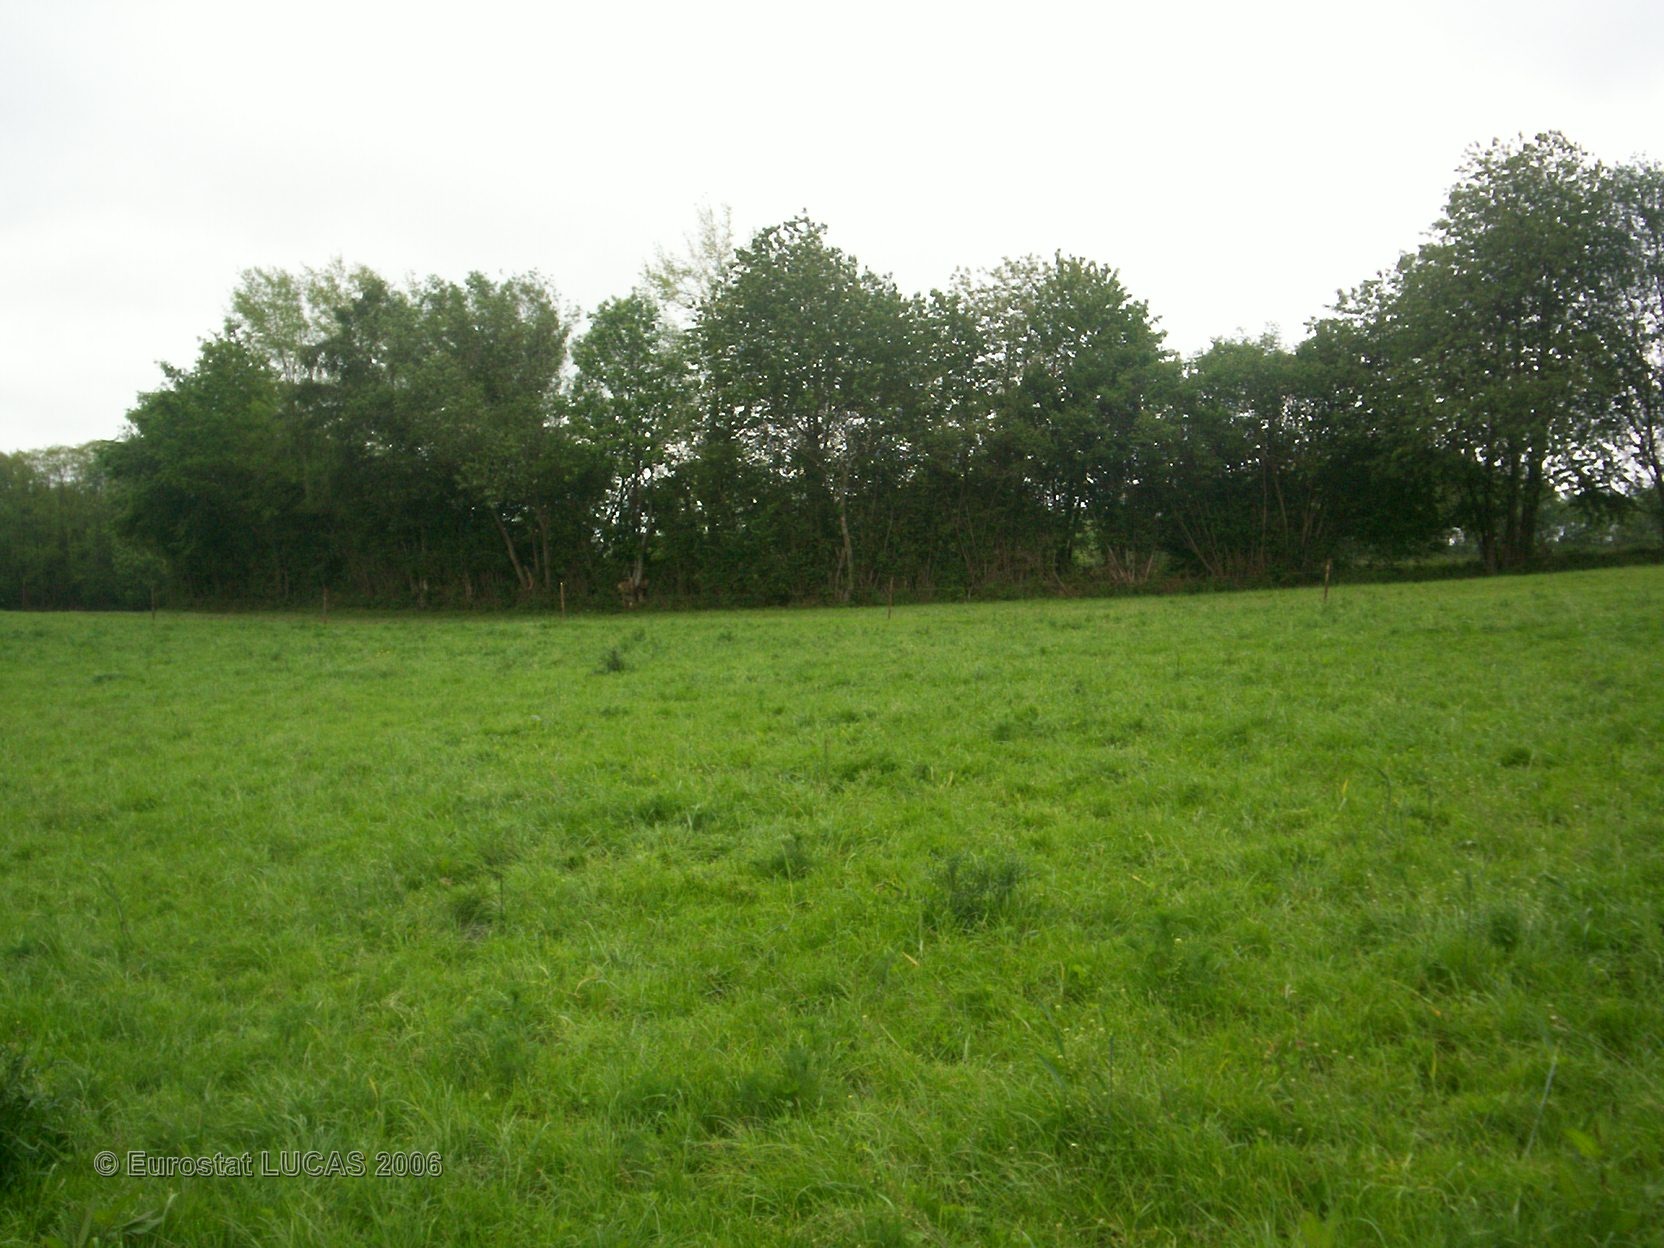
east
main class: Grassland
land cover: Grassland without tree/shrub cover
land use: Agriculture (excluding fallow land and kitchen gardens)
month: May
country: FR
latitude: 48.4300
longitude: 0.3103
